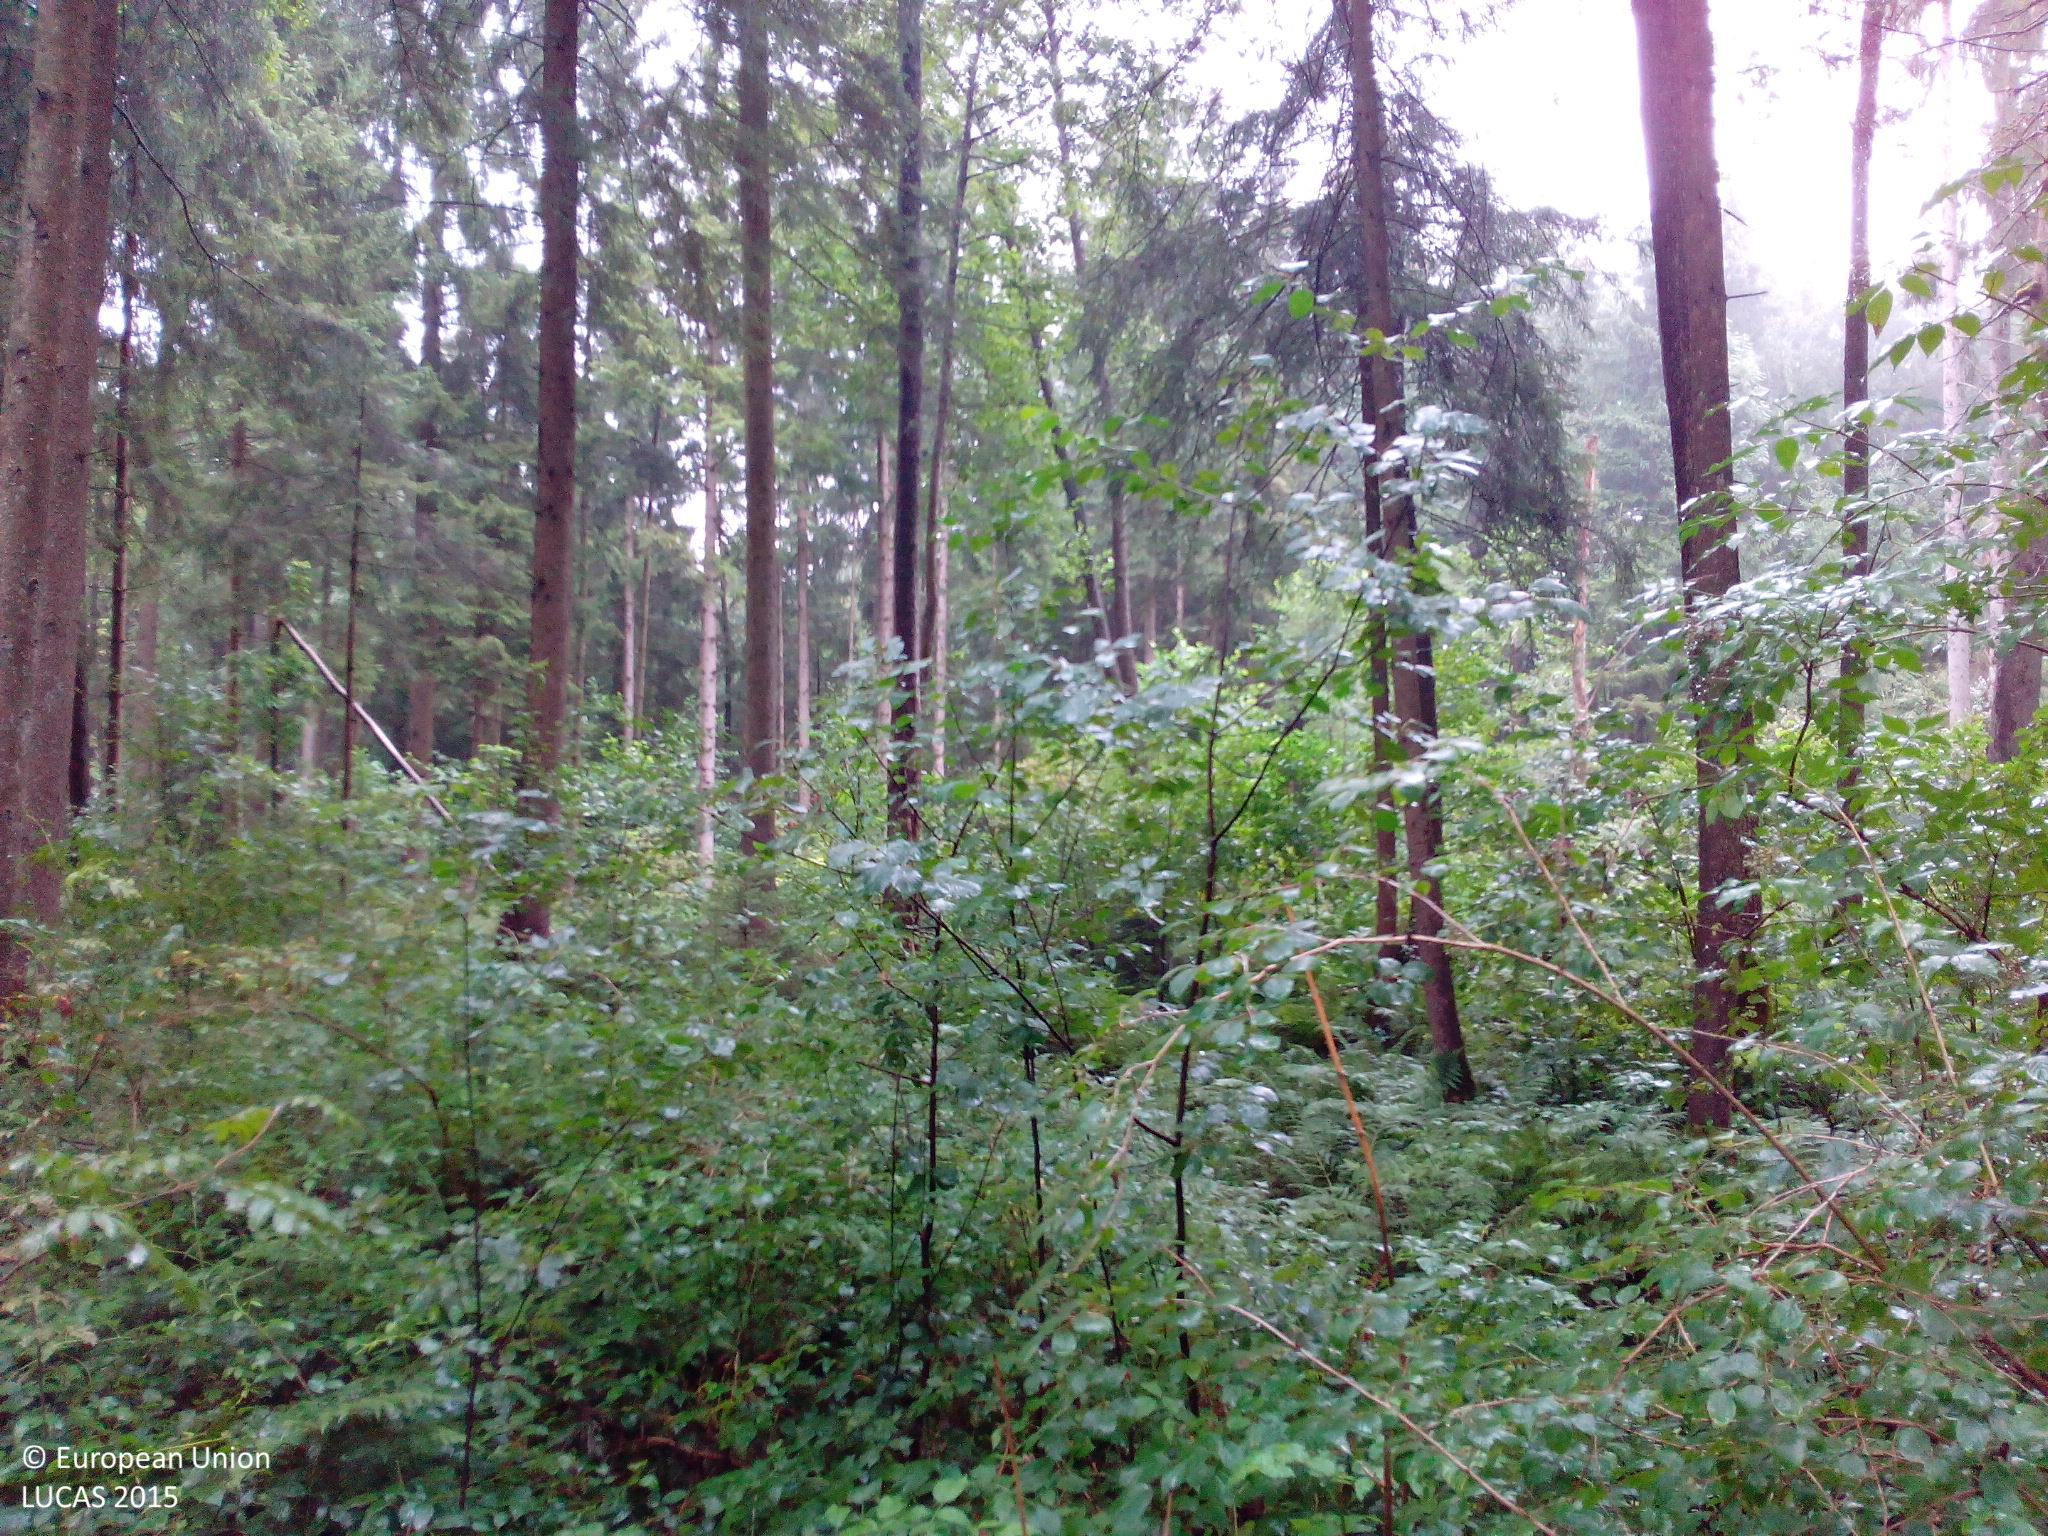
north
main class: Woodland
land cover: Spruce dominated coniferous woodland
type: hemiboreal forest and nemoral coniferous forest and mixed broadleaved-coniferous forest
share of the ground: > 75 %
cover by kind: coniferous forest trees 75 %, shrubs 20 %, broadleaved forest trees 5 %
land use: Forestry
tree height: > 5 m
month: August
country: DE
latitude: 47.8980
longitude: 12.8746
